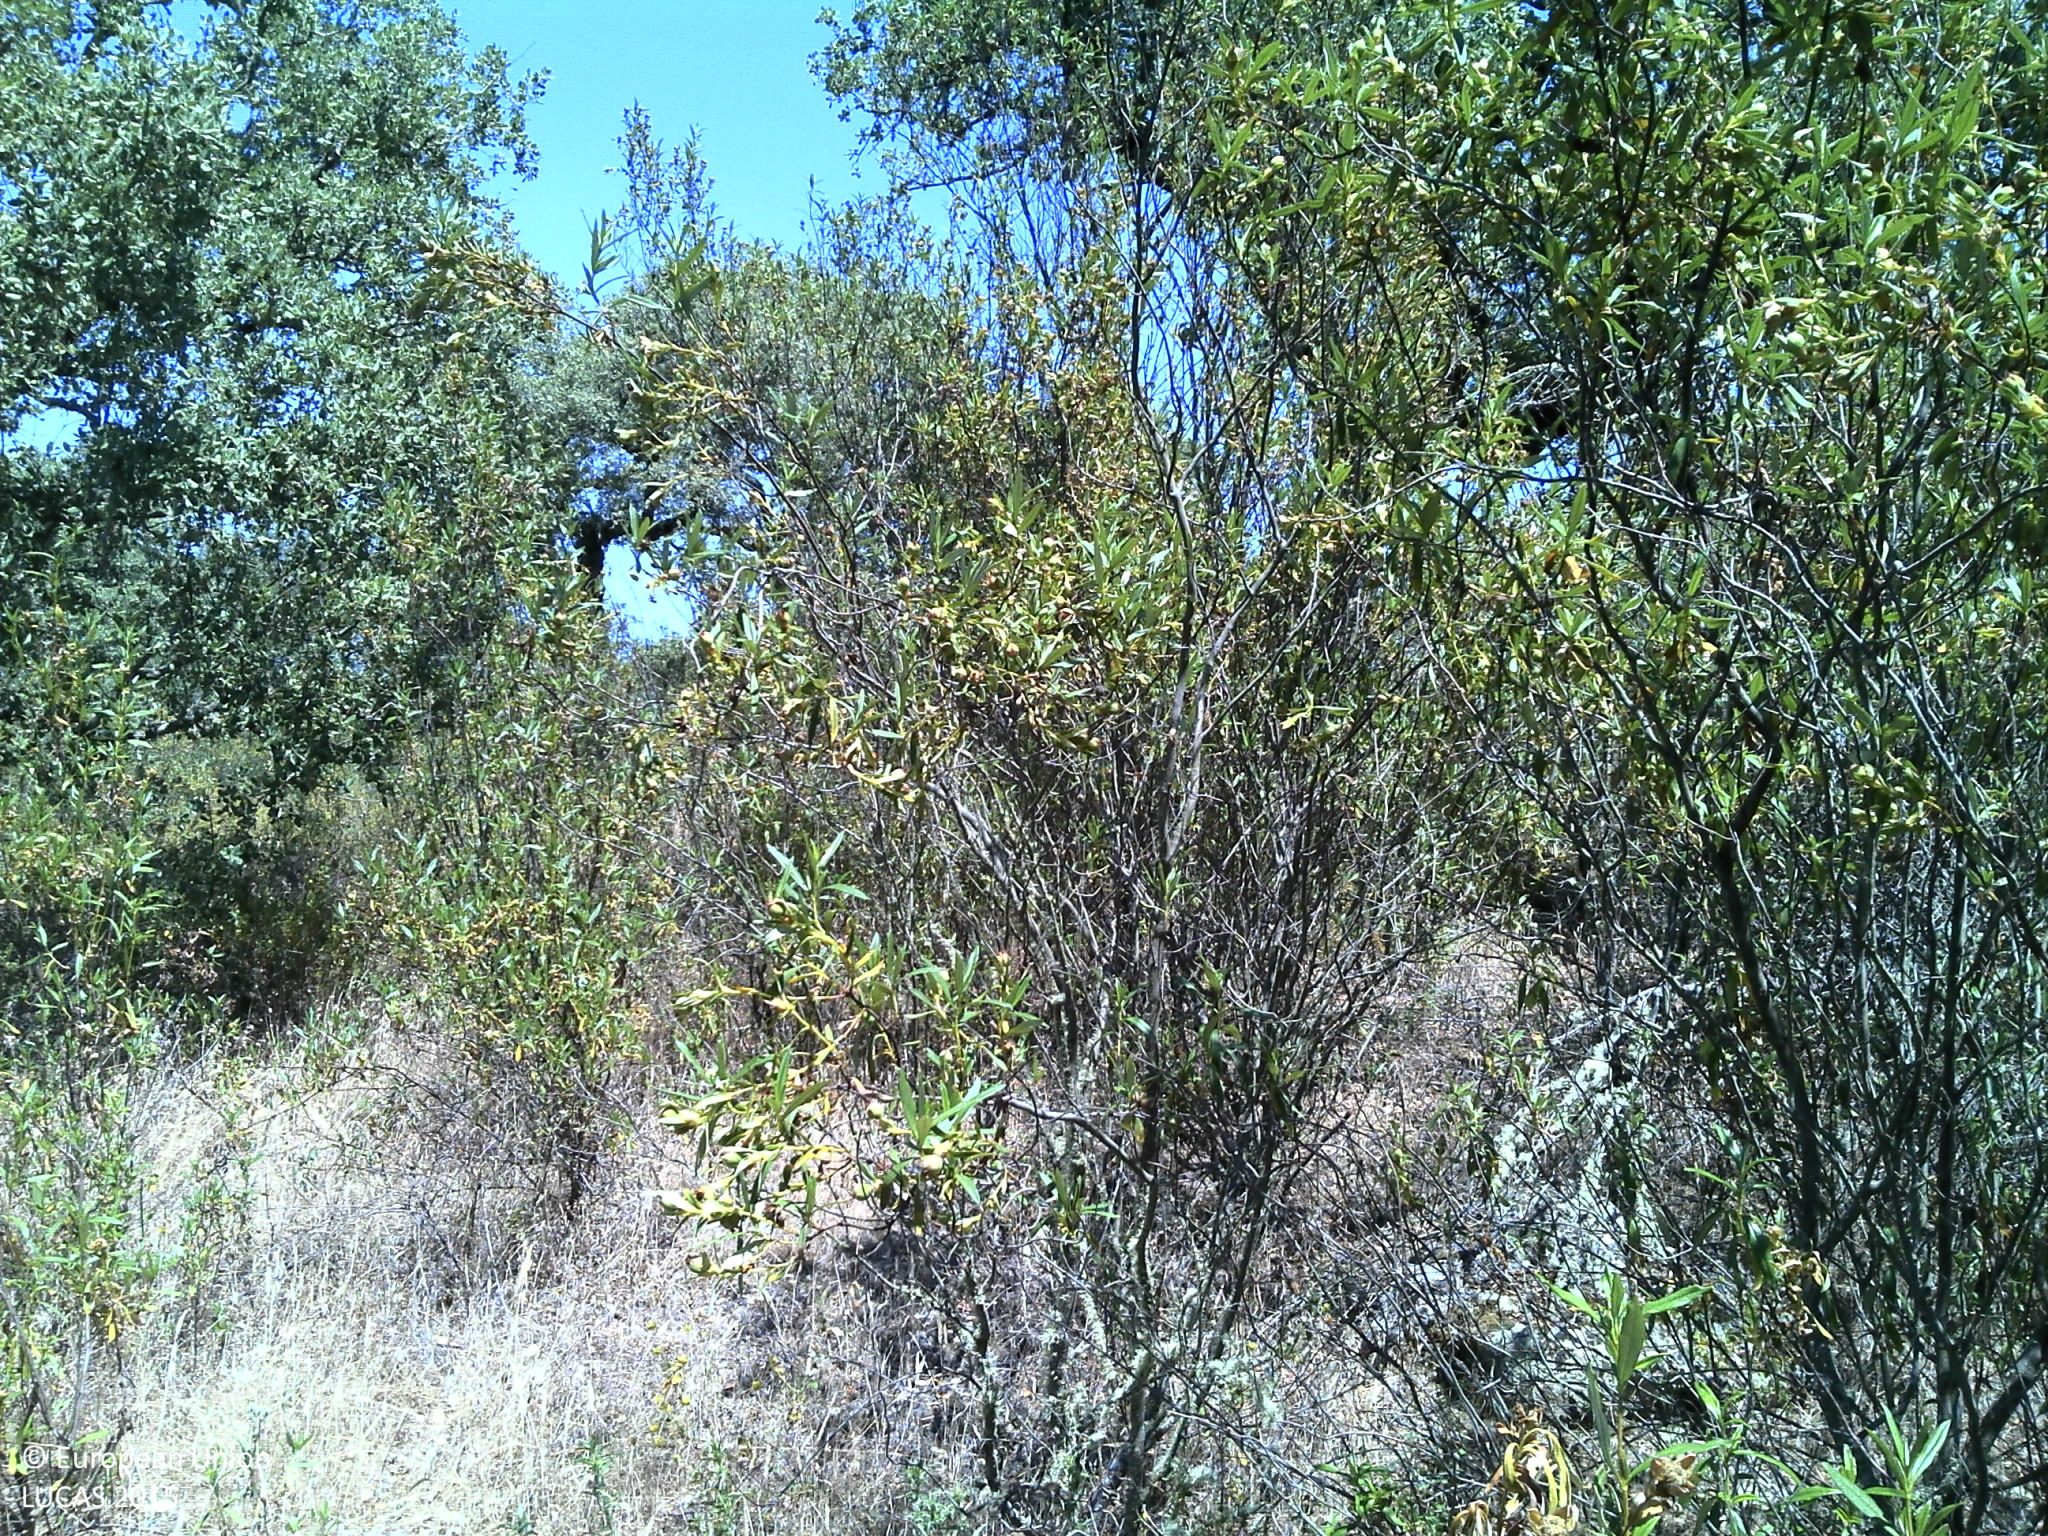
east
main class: Woodland
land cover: Broadleaved woodland
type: broadleaved evergreen forest
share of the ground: > 75 %
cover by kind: broadleaved forest trees 75 %, shrubs 20 %, herbaceous plants 5 %
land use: Forestry
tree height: > 5 m
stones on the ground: < 10 %
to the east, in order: Broadleaved woodland
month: May
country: PT
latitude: 38.7700
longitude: -8.1066
